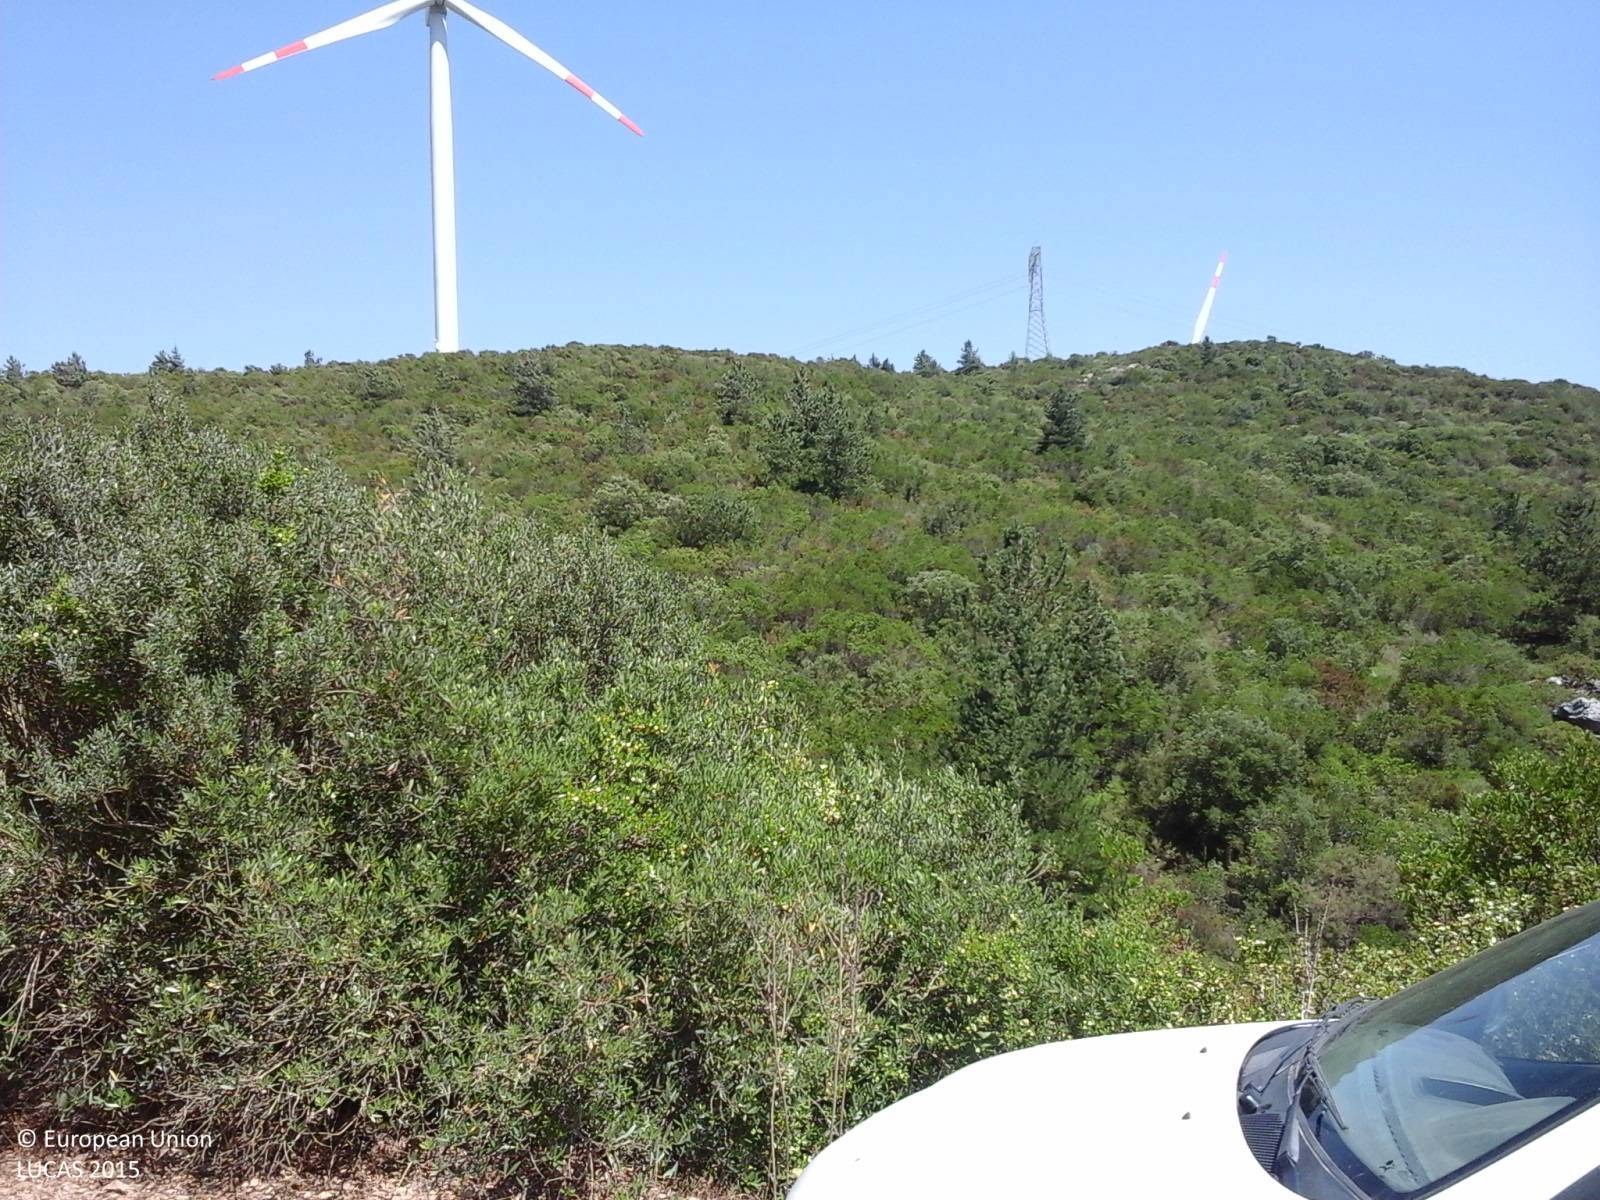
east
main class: Woodland
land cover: Broadleaved woodland
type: broadleaved evergreen forest
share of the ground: > 75 %
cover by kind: broadleaved forest trees 100 %
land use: Semi-natural and natural areas not in use
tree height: < 5 m
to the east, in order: Broadleaved woodland; Tracks; Shrubland with sparse tree cover; Broadleaved woodland; Shrubland without tree cover
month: June
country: IT
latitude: 39.8984
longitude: 8.8485
